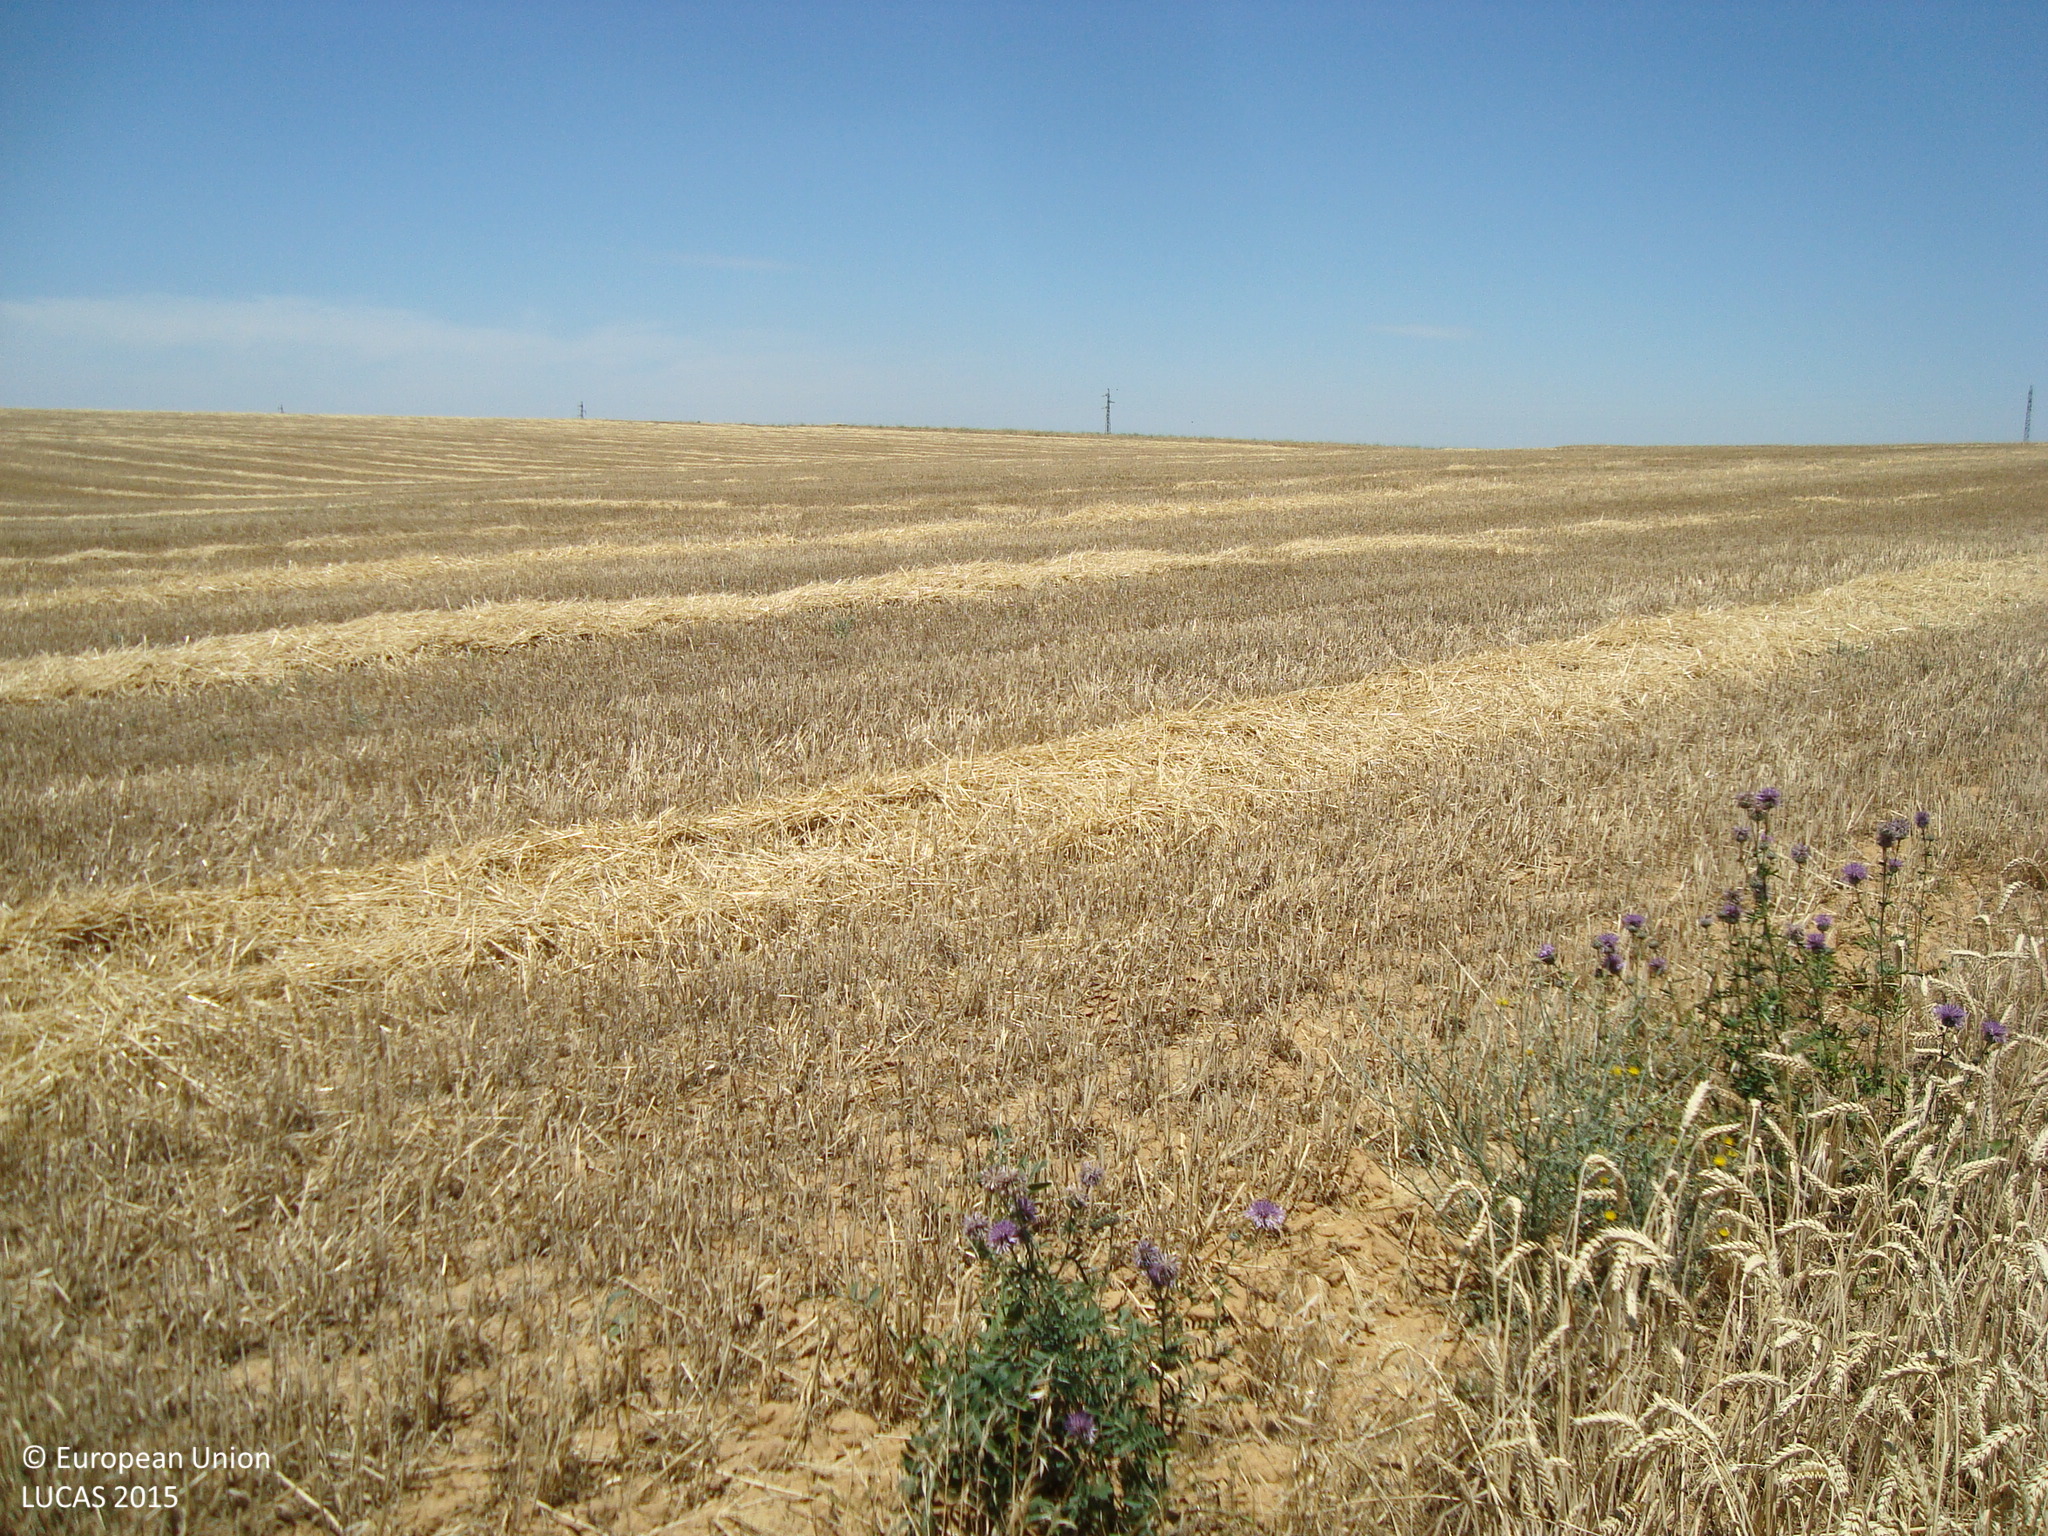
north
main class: Cropland
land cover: Common wheat
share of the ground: > 75 %
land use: Agriculture (excluding fallow land and kitchen gardens)
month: July
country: ES
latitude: 42.1495
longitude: -4.7791
